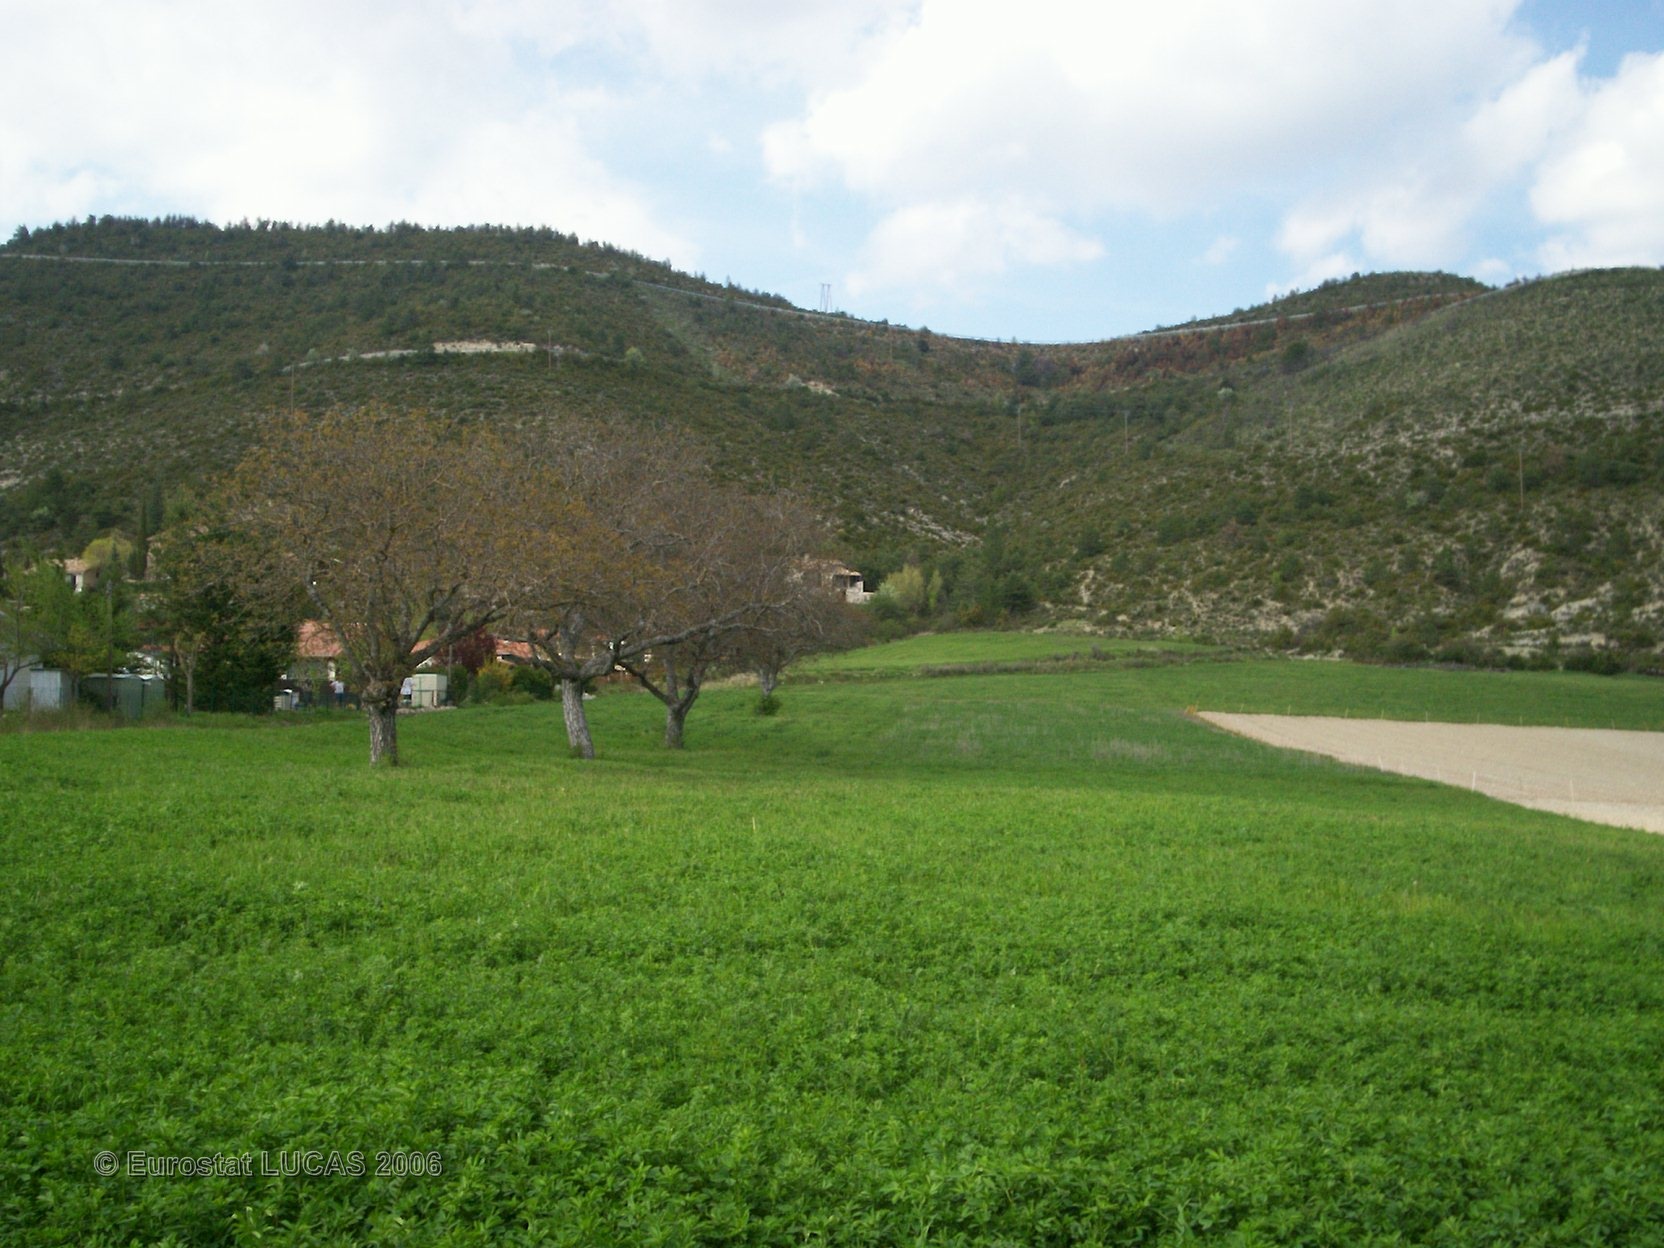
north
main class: Cropland
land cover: Lucerne
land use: Agriculture (excluding fallow land and kitchen gardens)
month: May
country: FR
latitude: 43.8766
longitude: 6.5106
